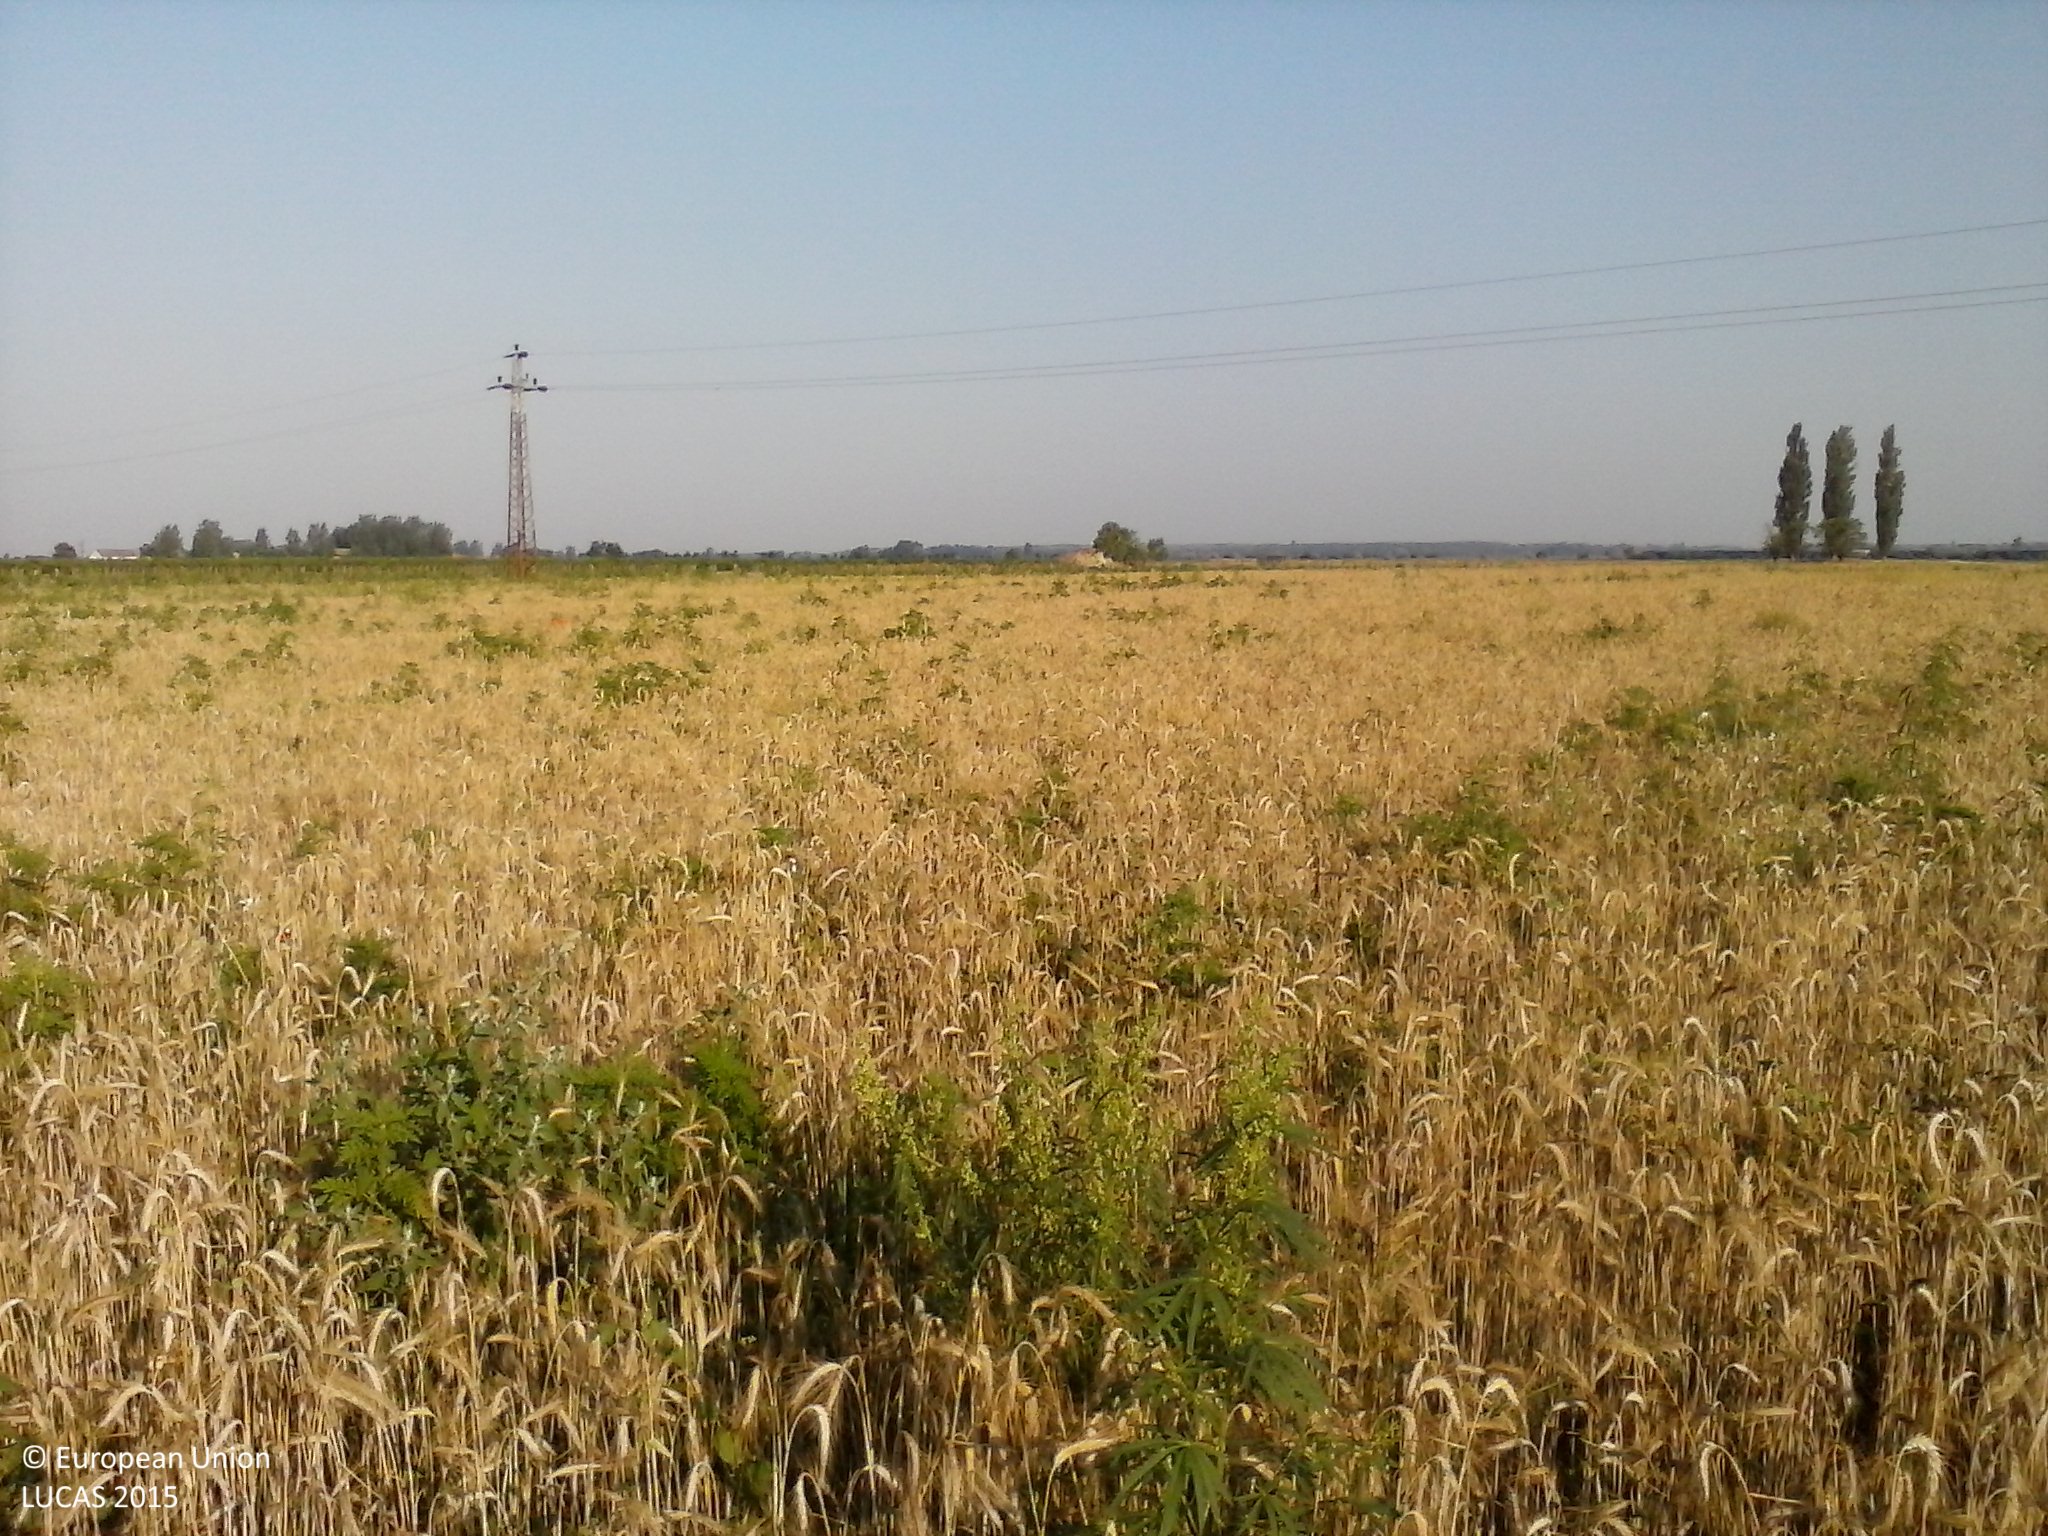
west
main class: Cropland
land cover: Common wheat
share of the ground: > 75 %
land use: Agriculture (excluding fallow land and kitchen gardens)
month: July
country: HU
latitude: 46.4456
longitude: 19.5856
